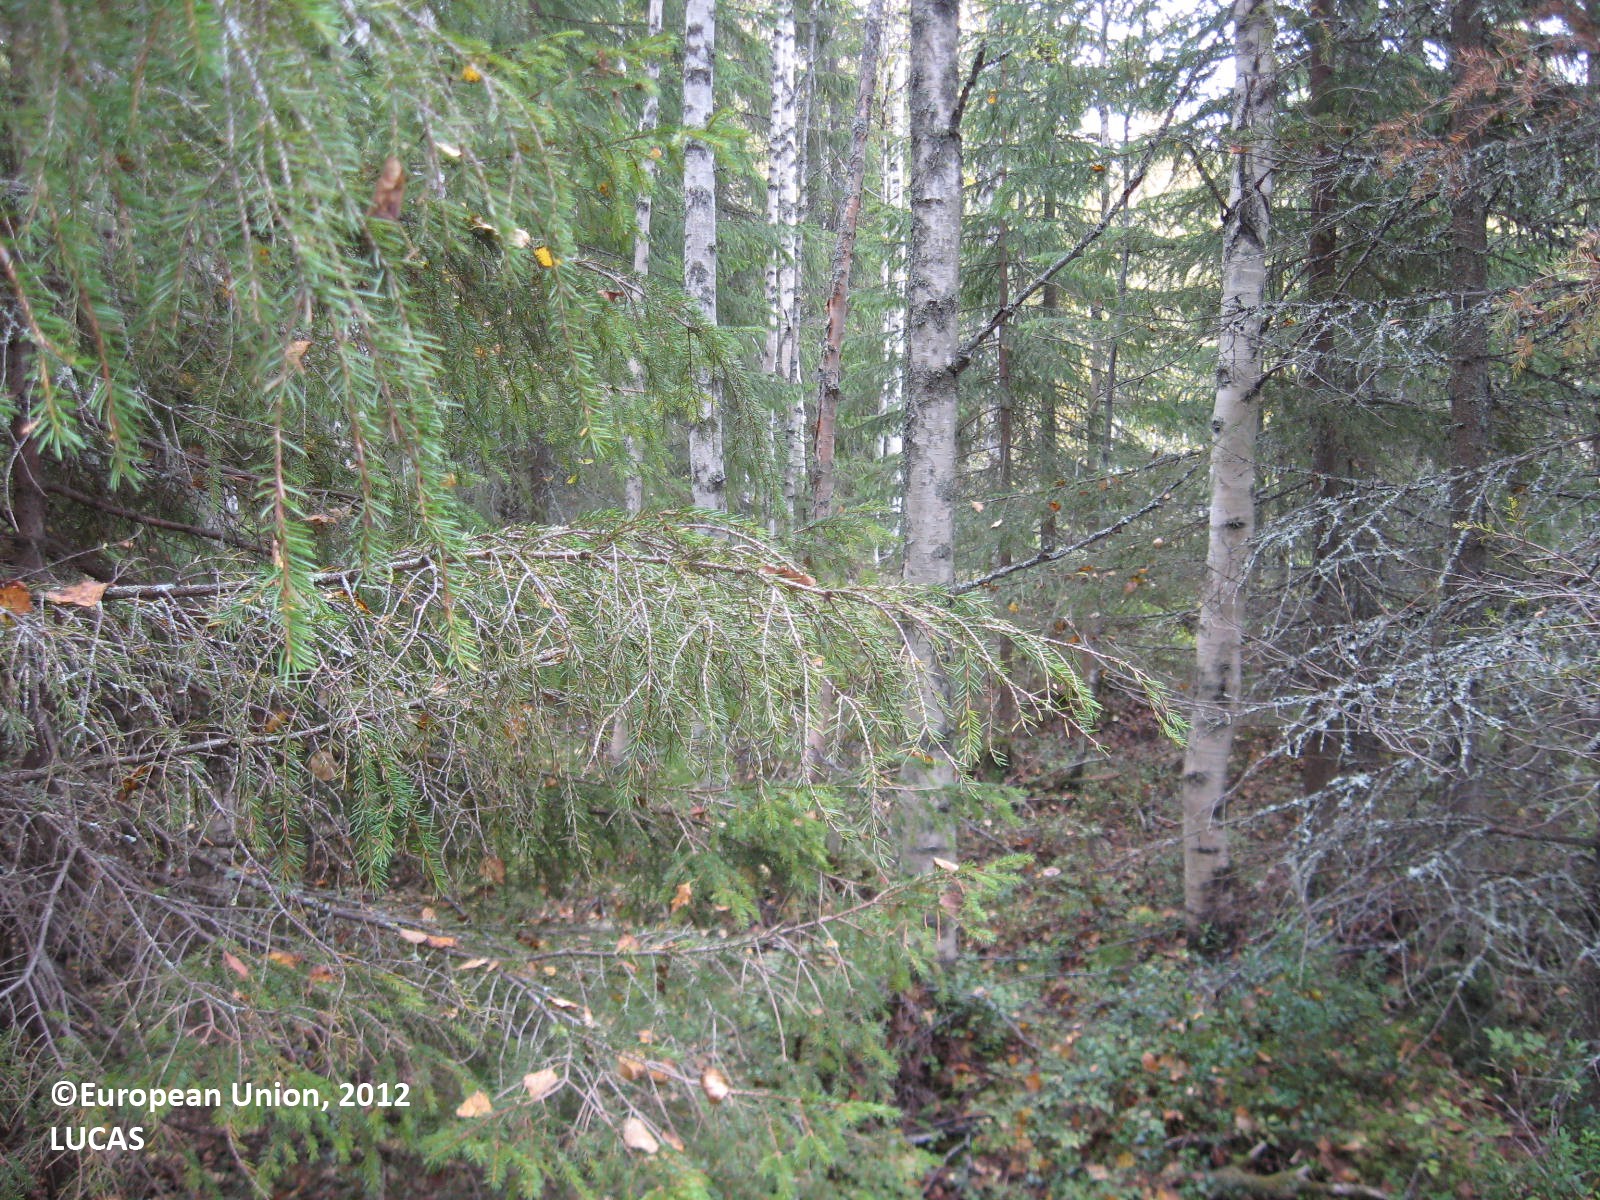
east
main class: Woodland
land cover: Other mixed woodland
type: boreal forest
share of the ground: > 75 %
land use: Forestry
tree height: > 5 m
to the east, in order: Other mixed woodland; Other coniferous woodland
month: August
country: FI
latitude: 63.8894
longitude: 29.1268
